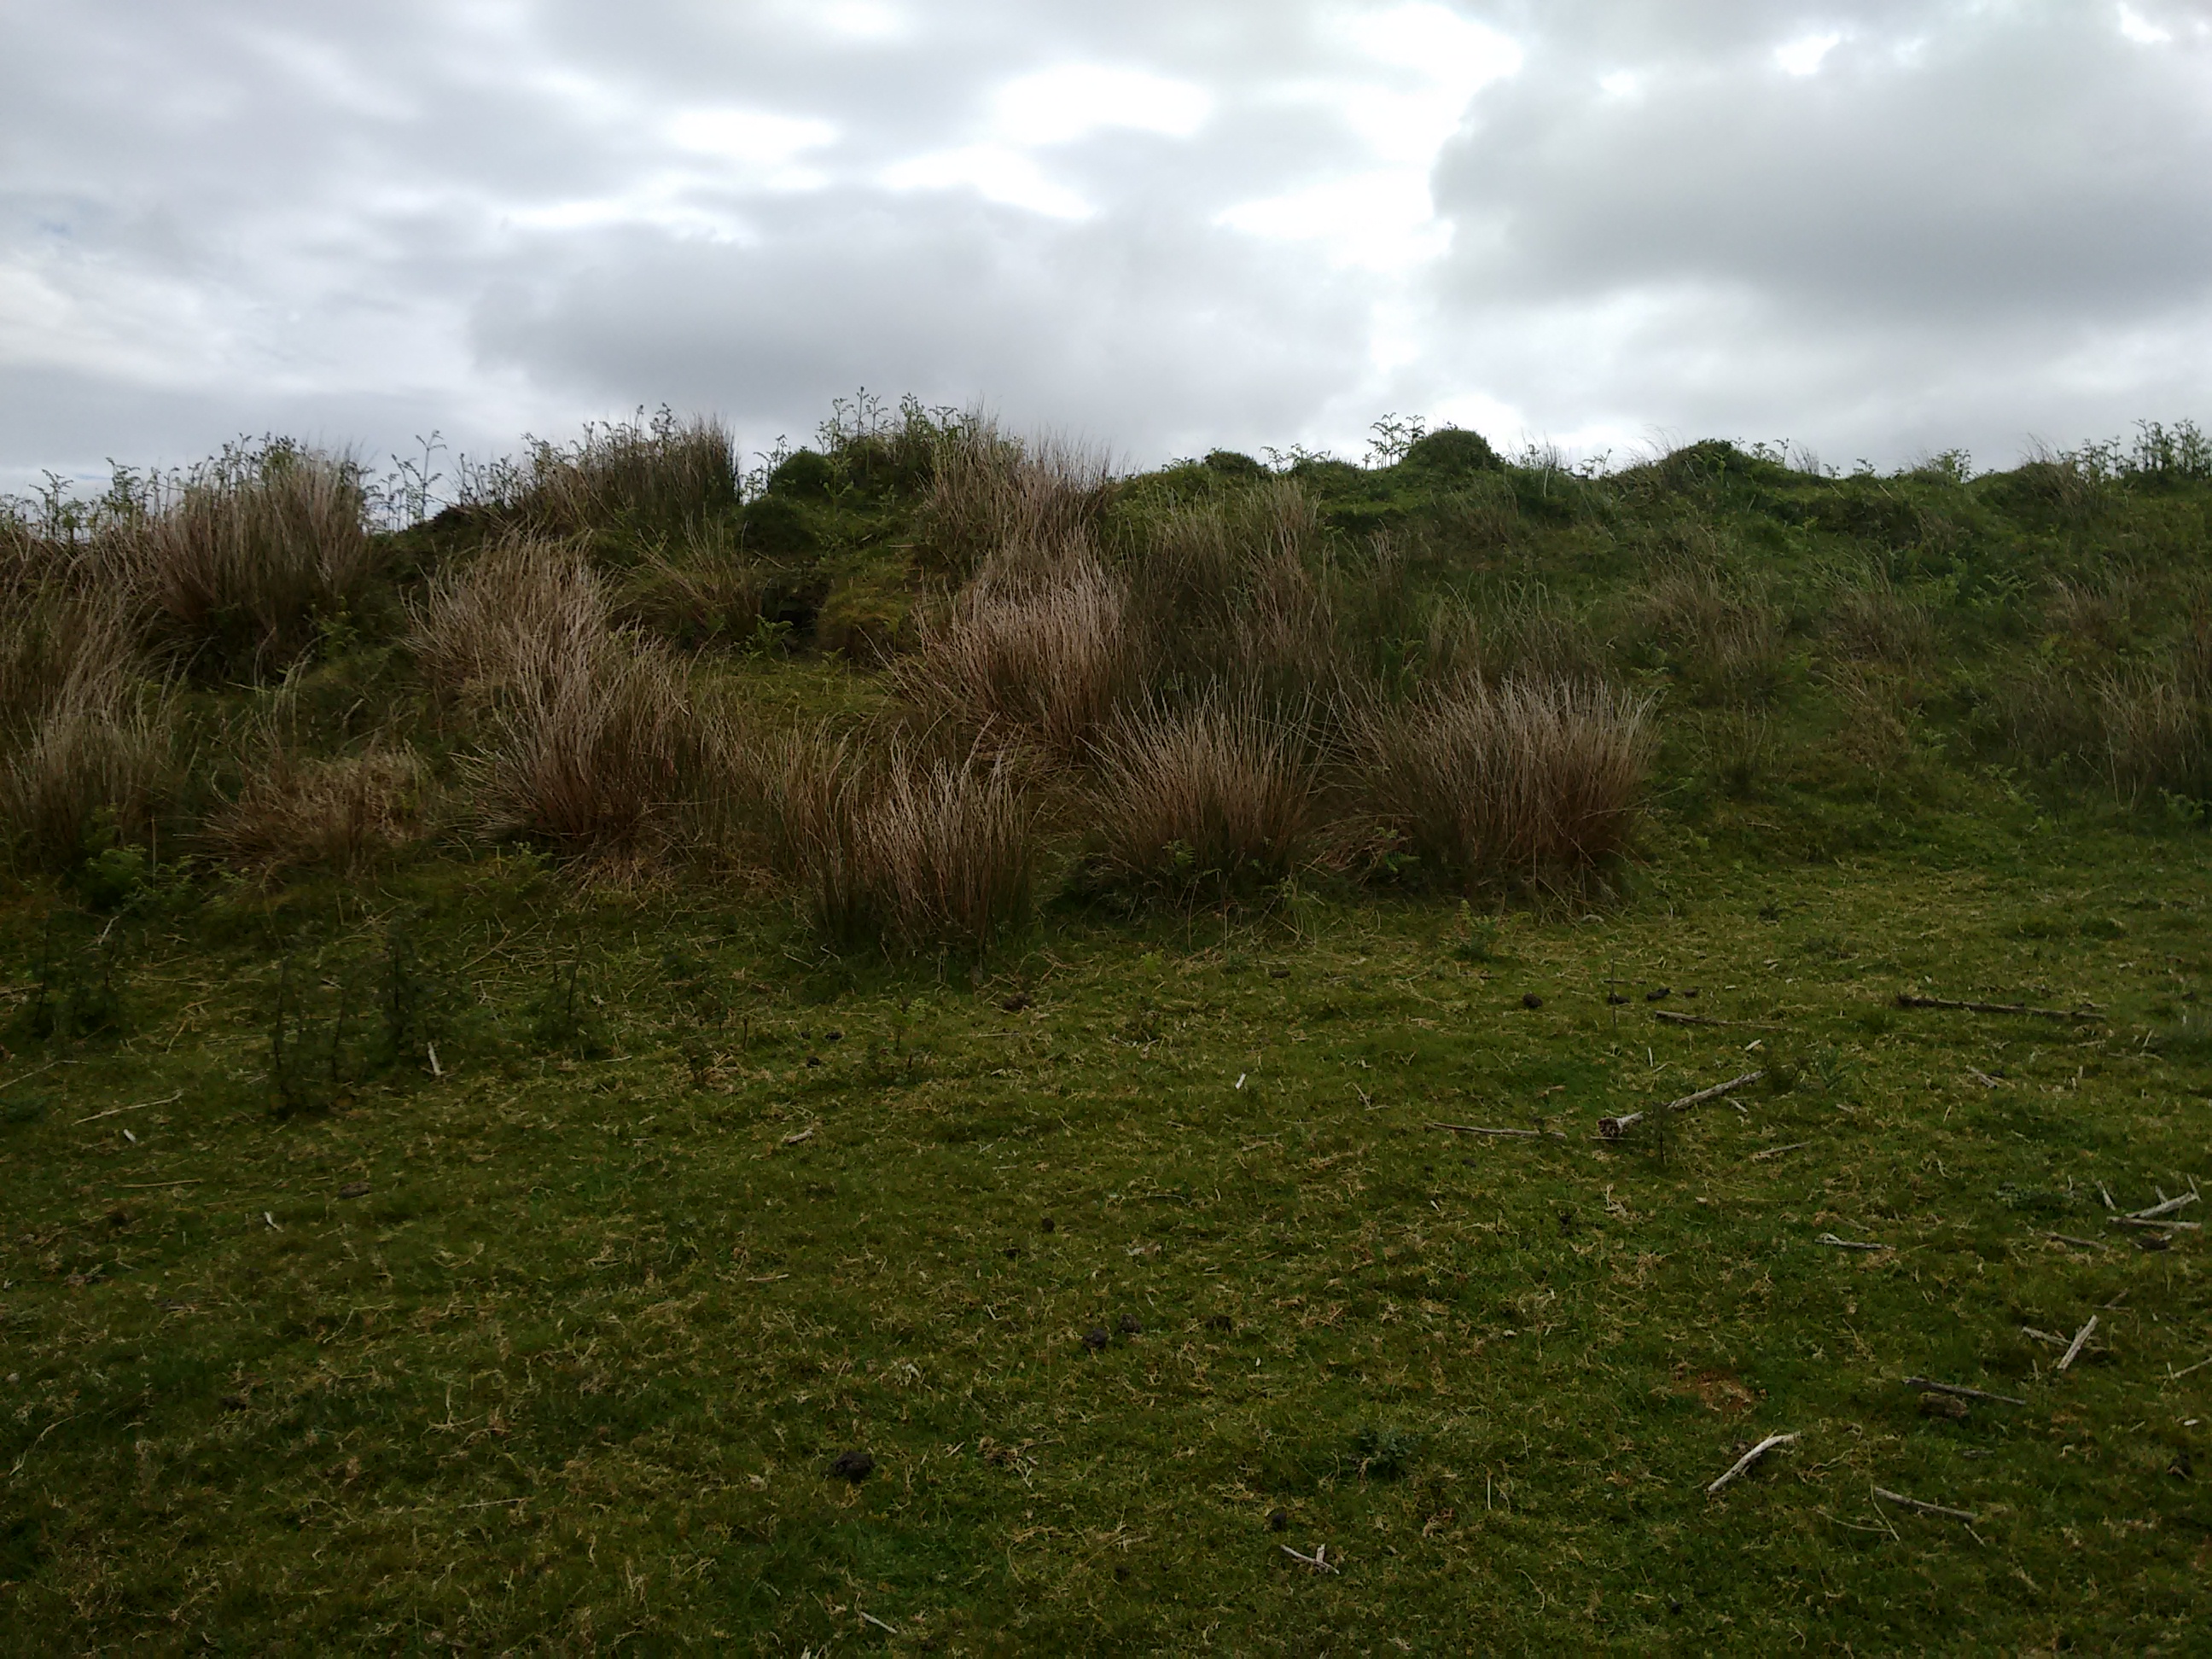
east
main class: Grassland
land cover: Grassland without tree/shrub cover
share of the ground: > 75 %
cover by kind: herbaceous plants 100 %
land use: Agriculture (excluding fallow land and kitchen gardens)
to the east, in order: Grassland without tree/shrub cover; Sand; Grassland without tree/shrub cover; Fences; Broadleaved woodland; Tracks
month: June
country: GB
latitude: 54.8808
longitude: -6.9550
